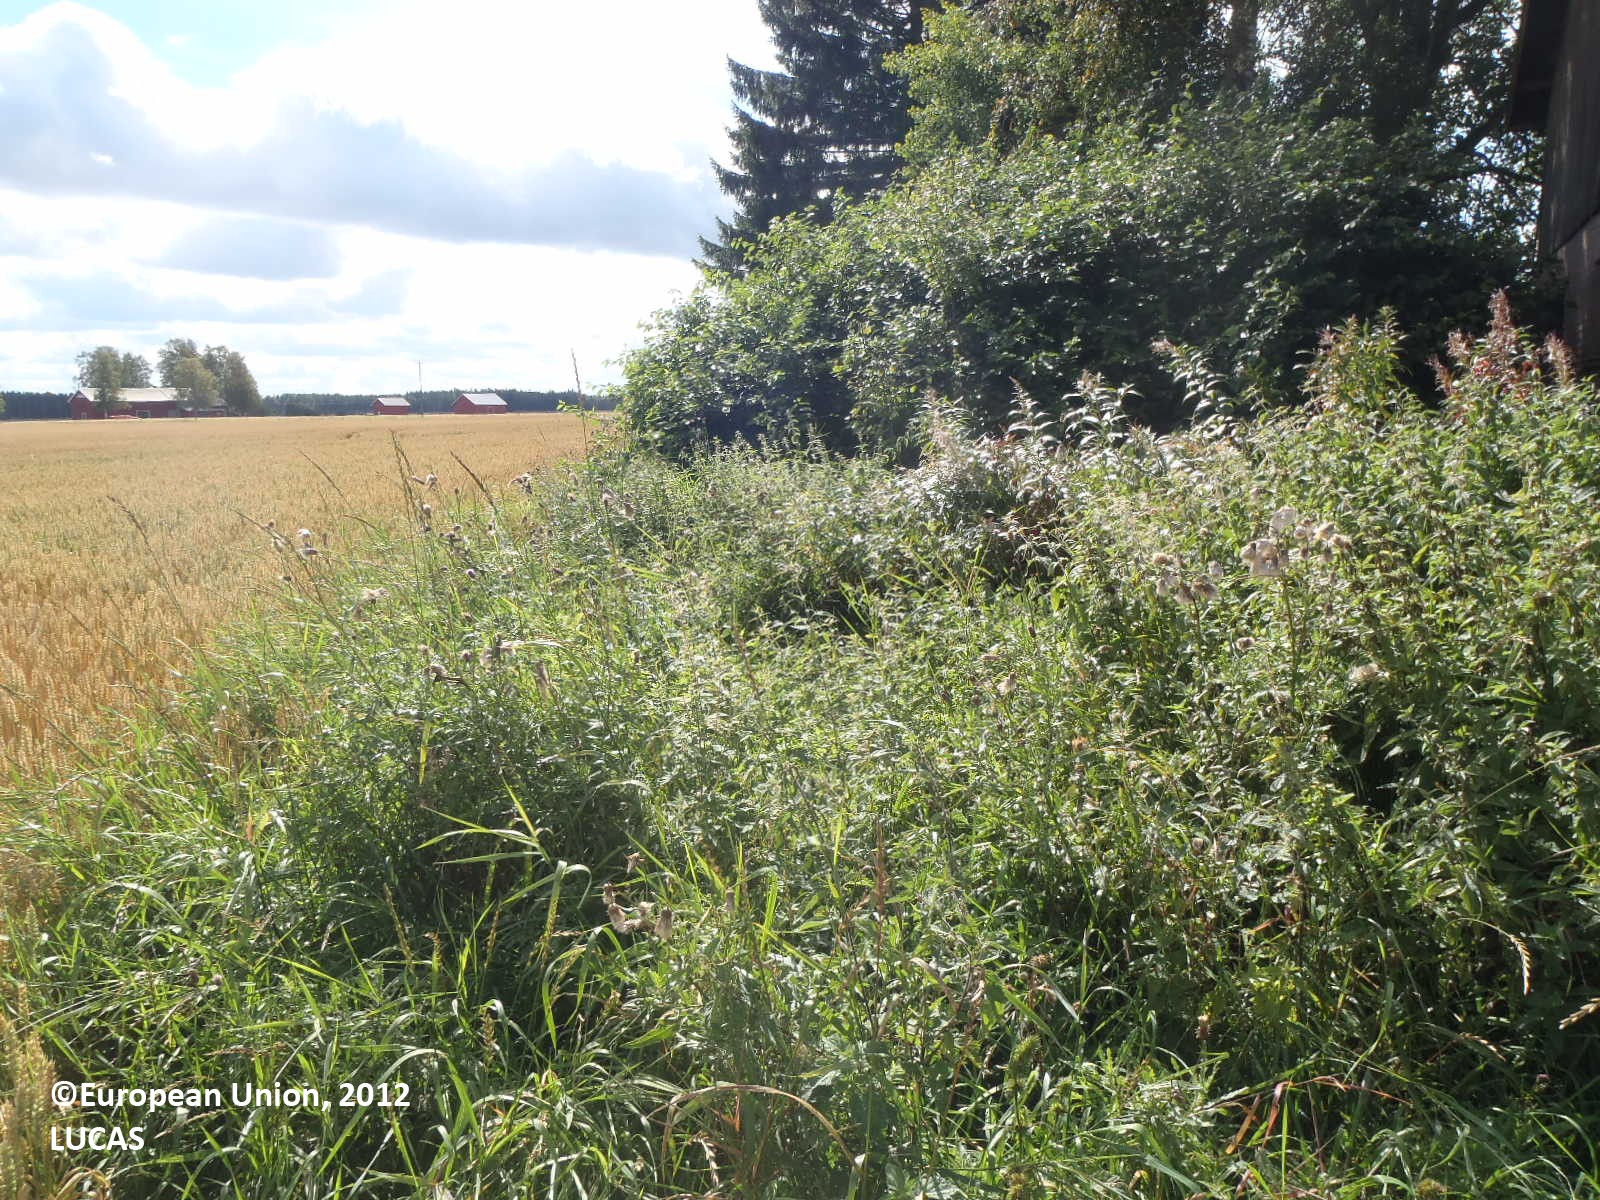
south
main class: Cropland
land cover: Common wheat
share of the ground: > 75 %
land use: Agriculture (excluding fallow land and kitchen gardens)
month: September
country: FI
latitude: 60.9078
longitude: 22.6253
